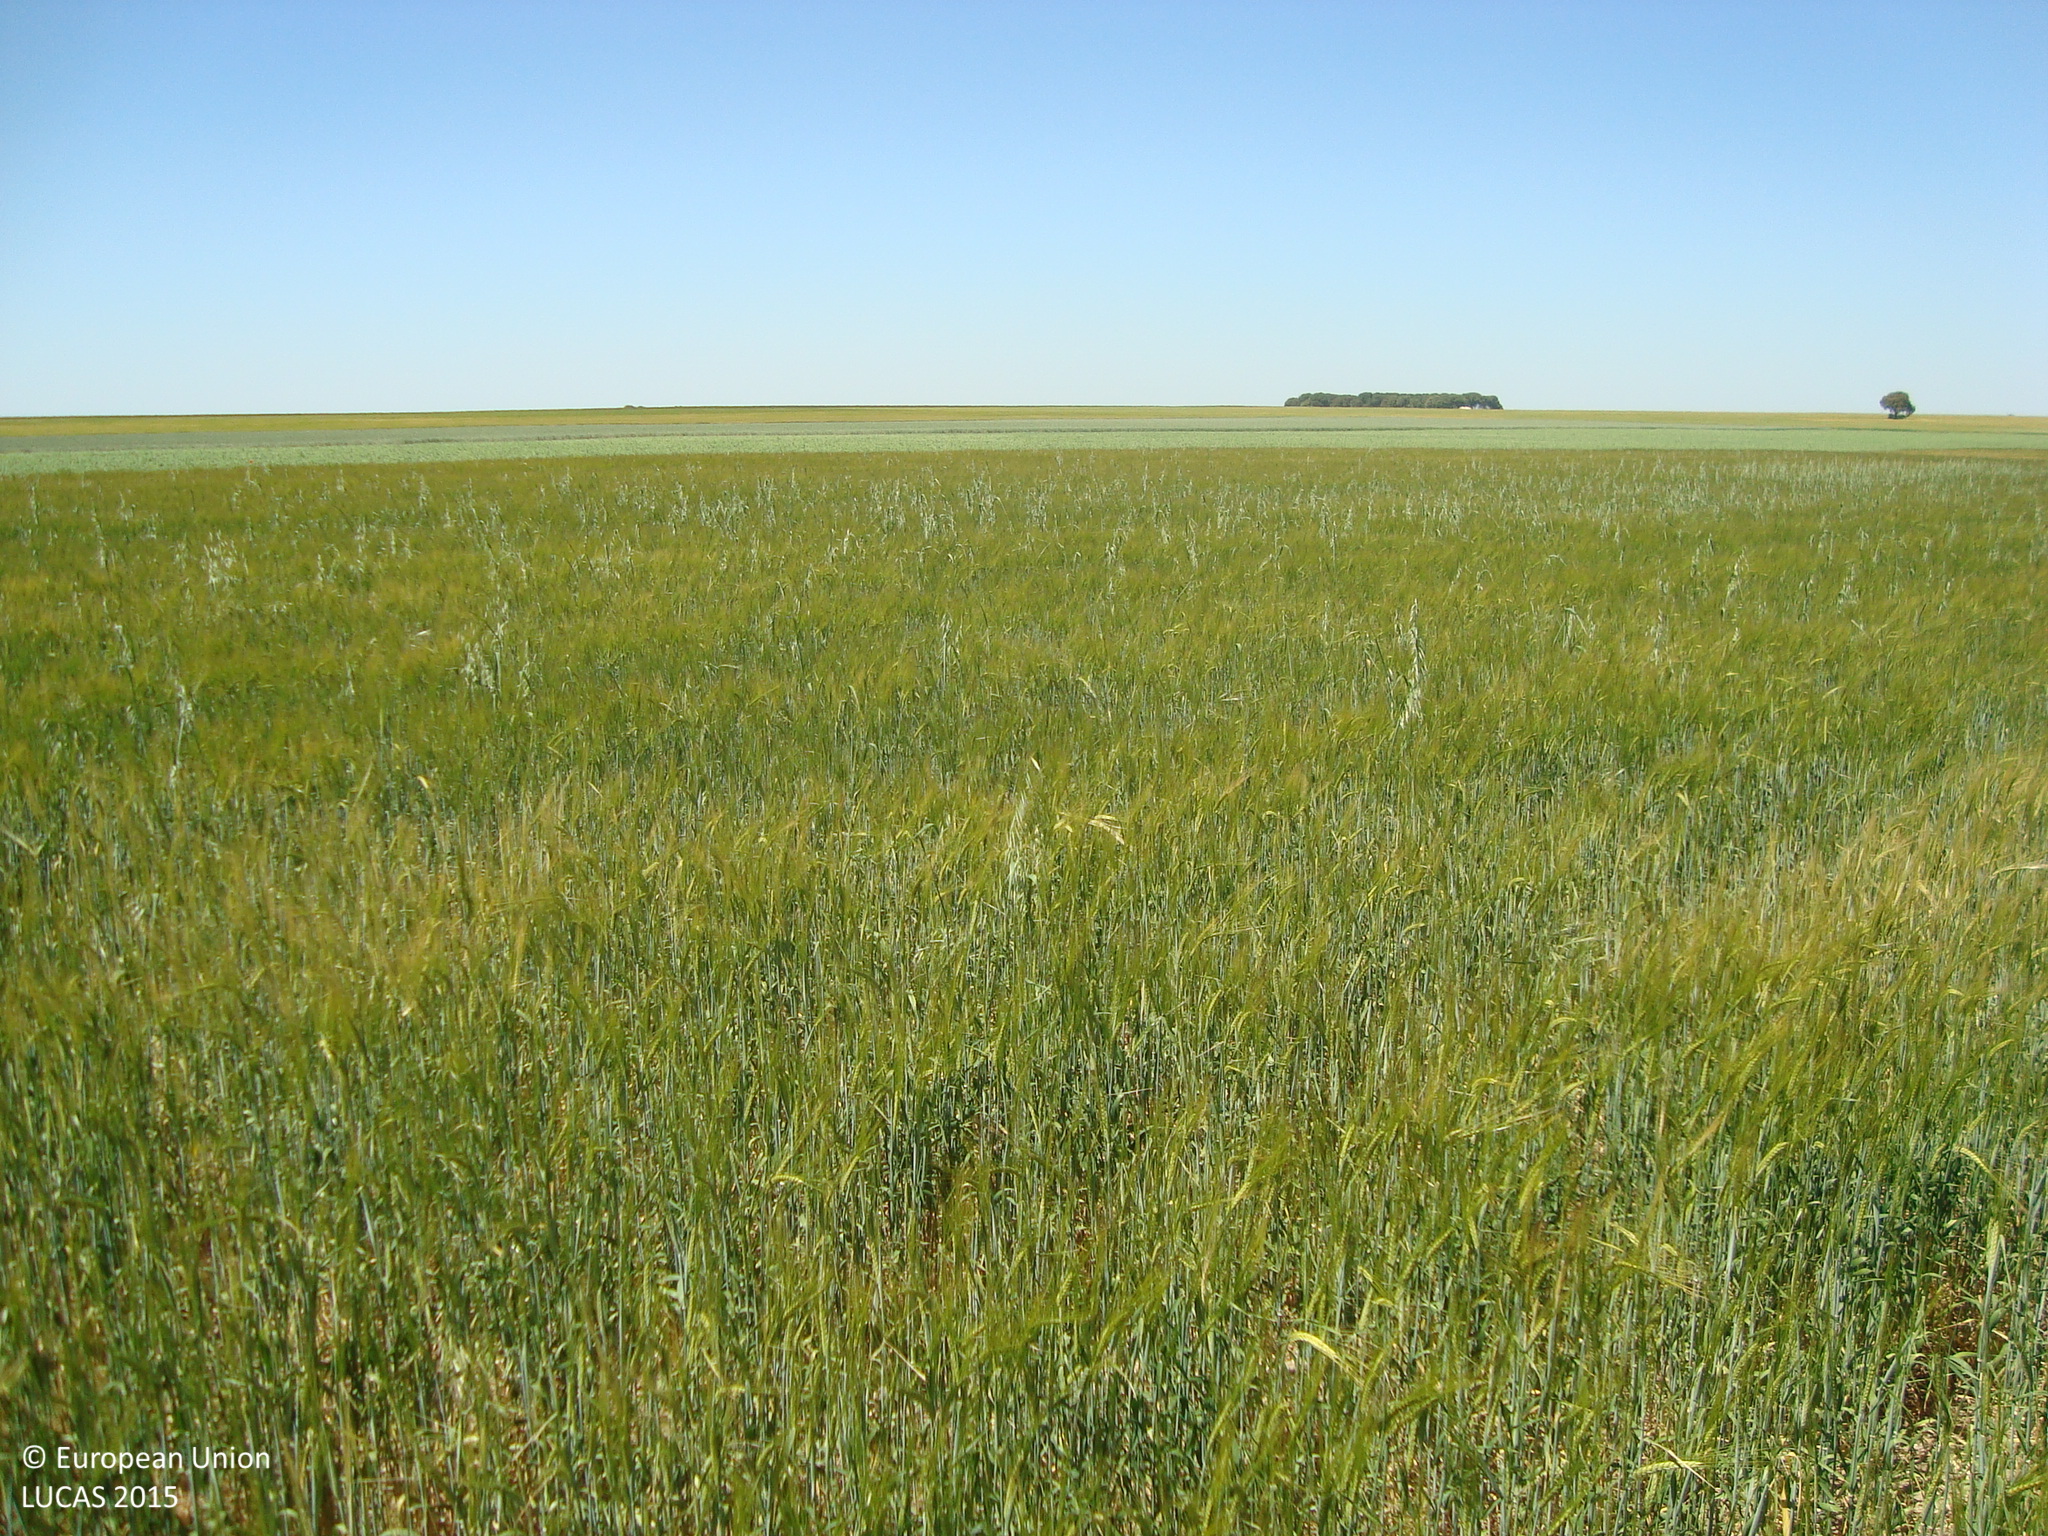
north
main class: Cropland
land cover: Mixed cereals for fodder
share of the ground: > 75 %
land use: Agriculture (excluding fallow land and kitchen gardens)
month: May
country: ES
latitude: 41.4995
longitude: -4.0845
